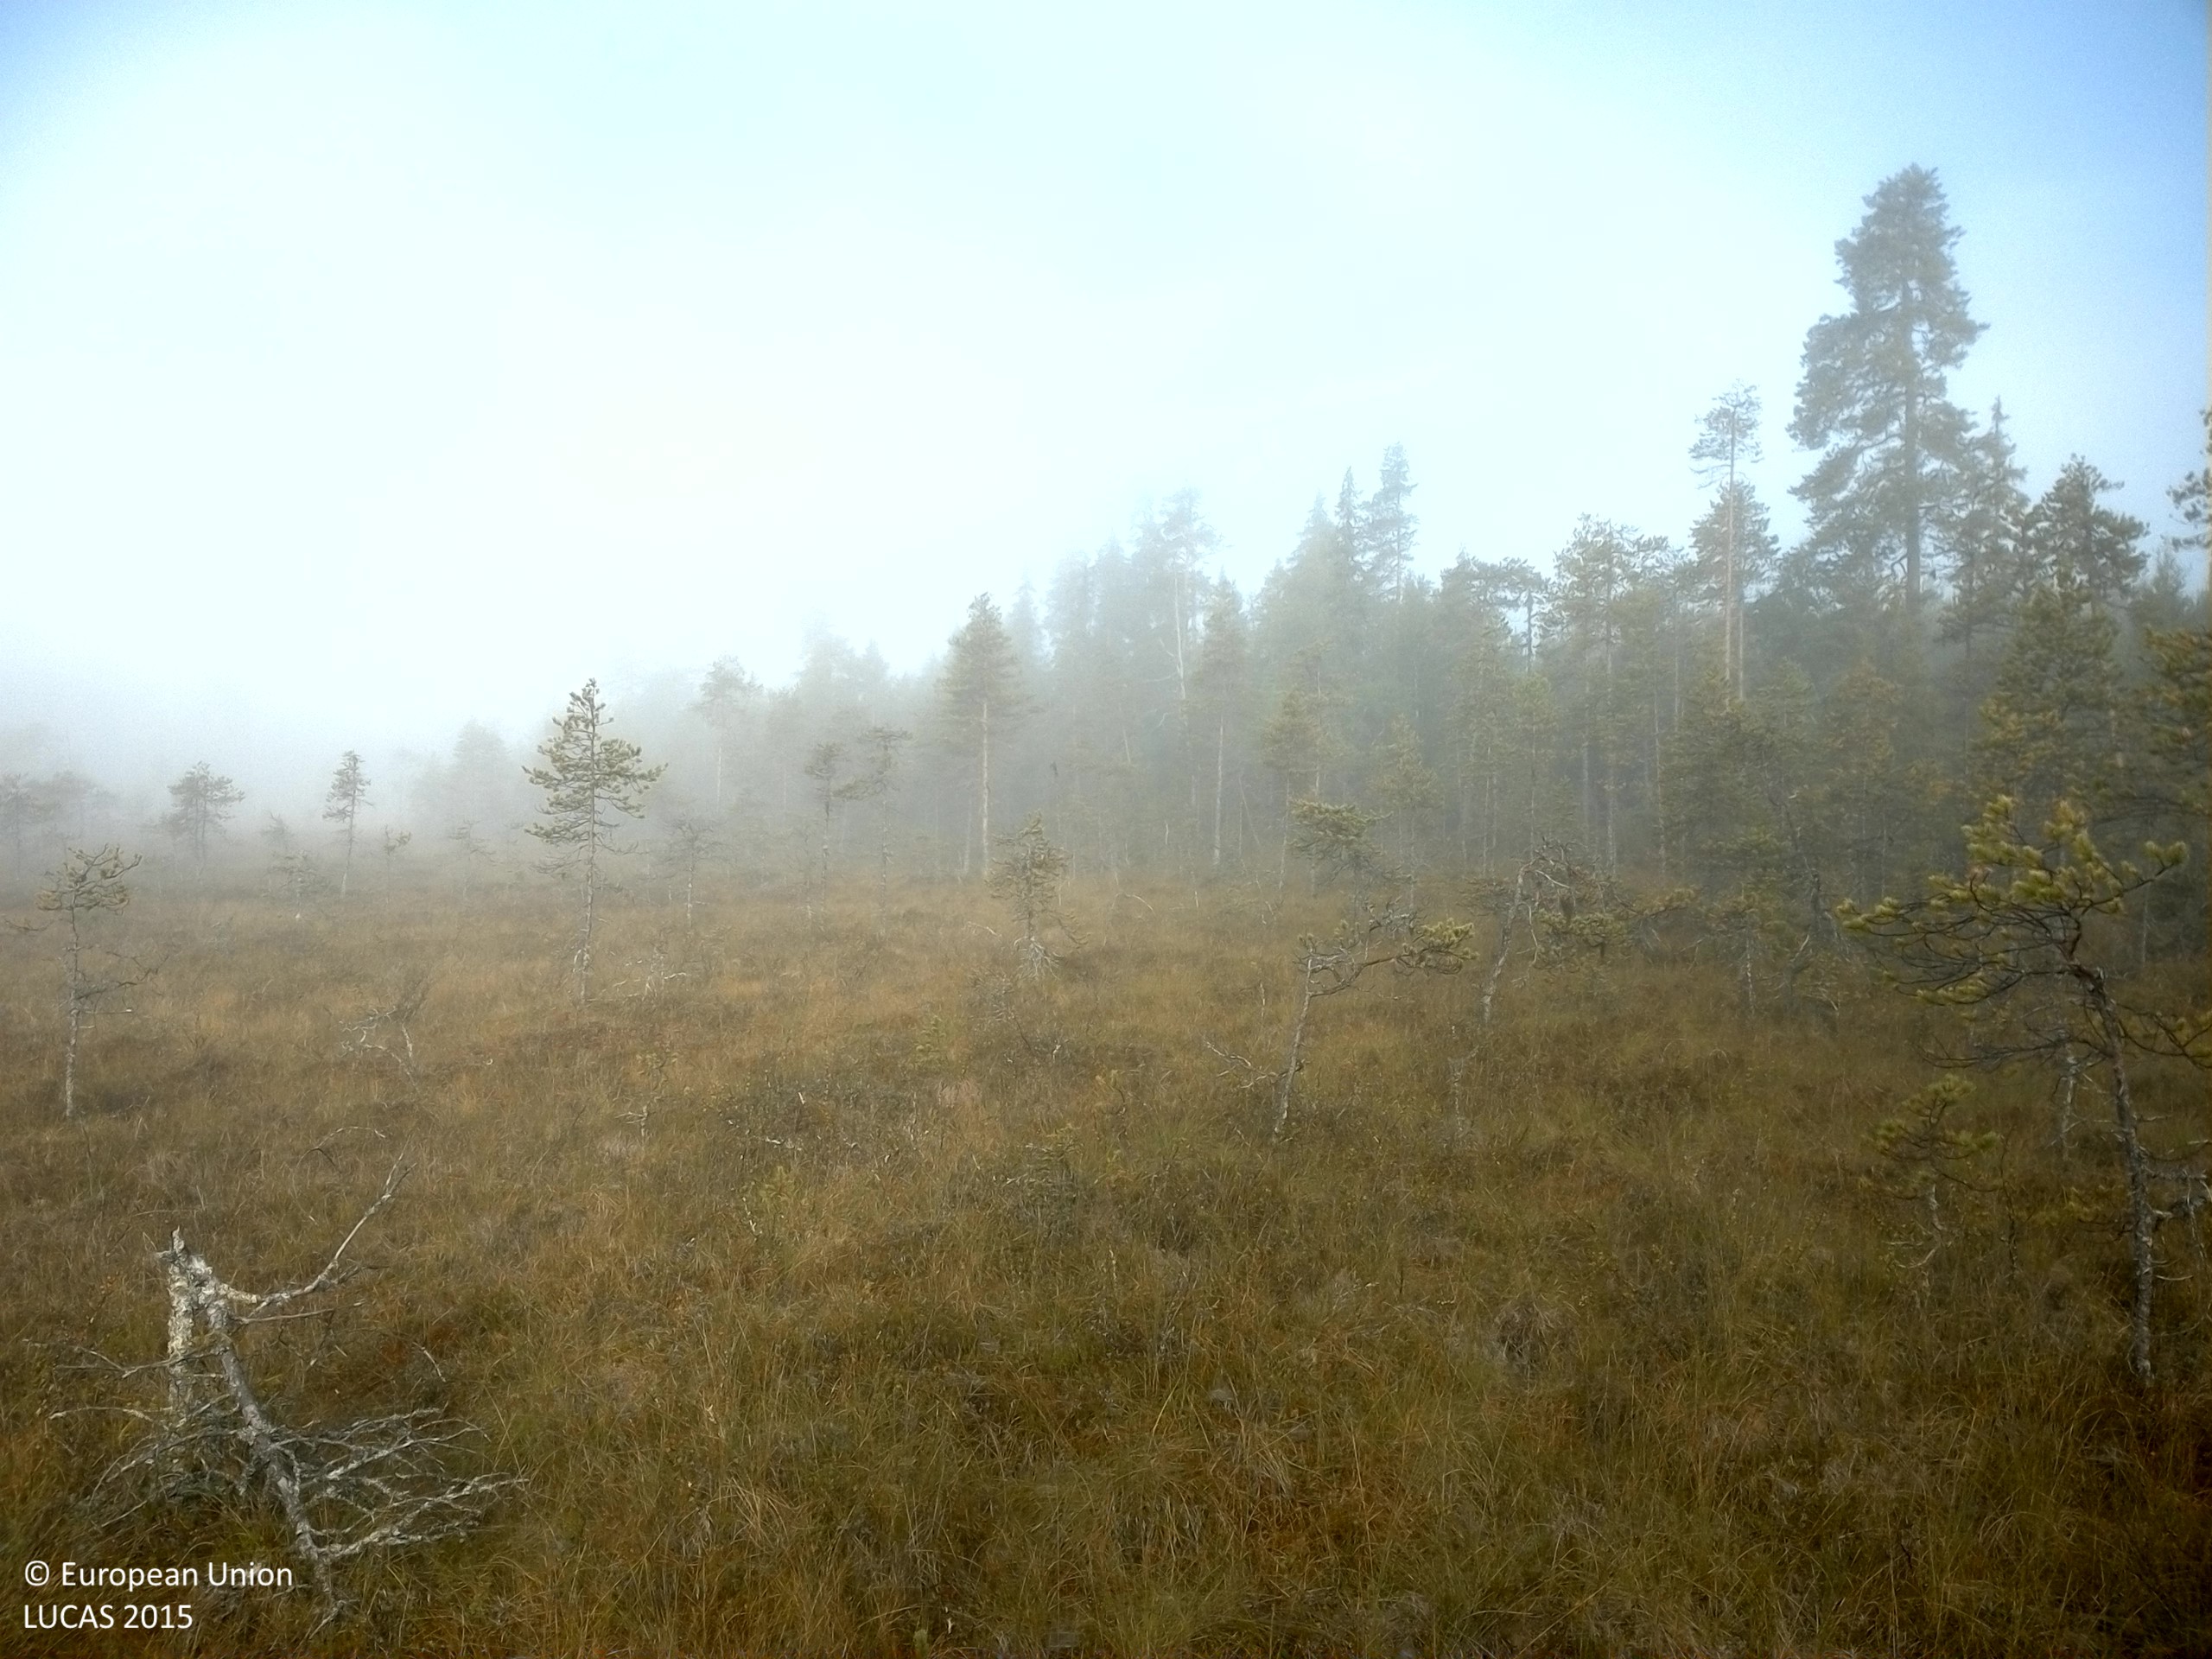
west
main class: Woodland
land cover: Pine dominated coniferous woodland
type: boreal forest
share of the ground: 10 - 25 %
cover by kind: lichens and mosses 40 %, herbaceous plants 25 %, shrubs 20 %, coniferous forest trees 15 %
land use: Semi-natural and natural areas not in use
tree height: < 5 m
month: September
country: SE
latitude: 64.0143
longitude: 17.6418
